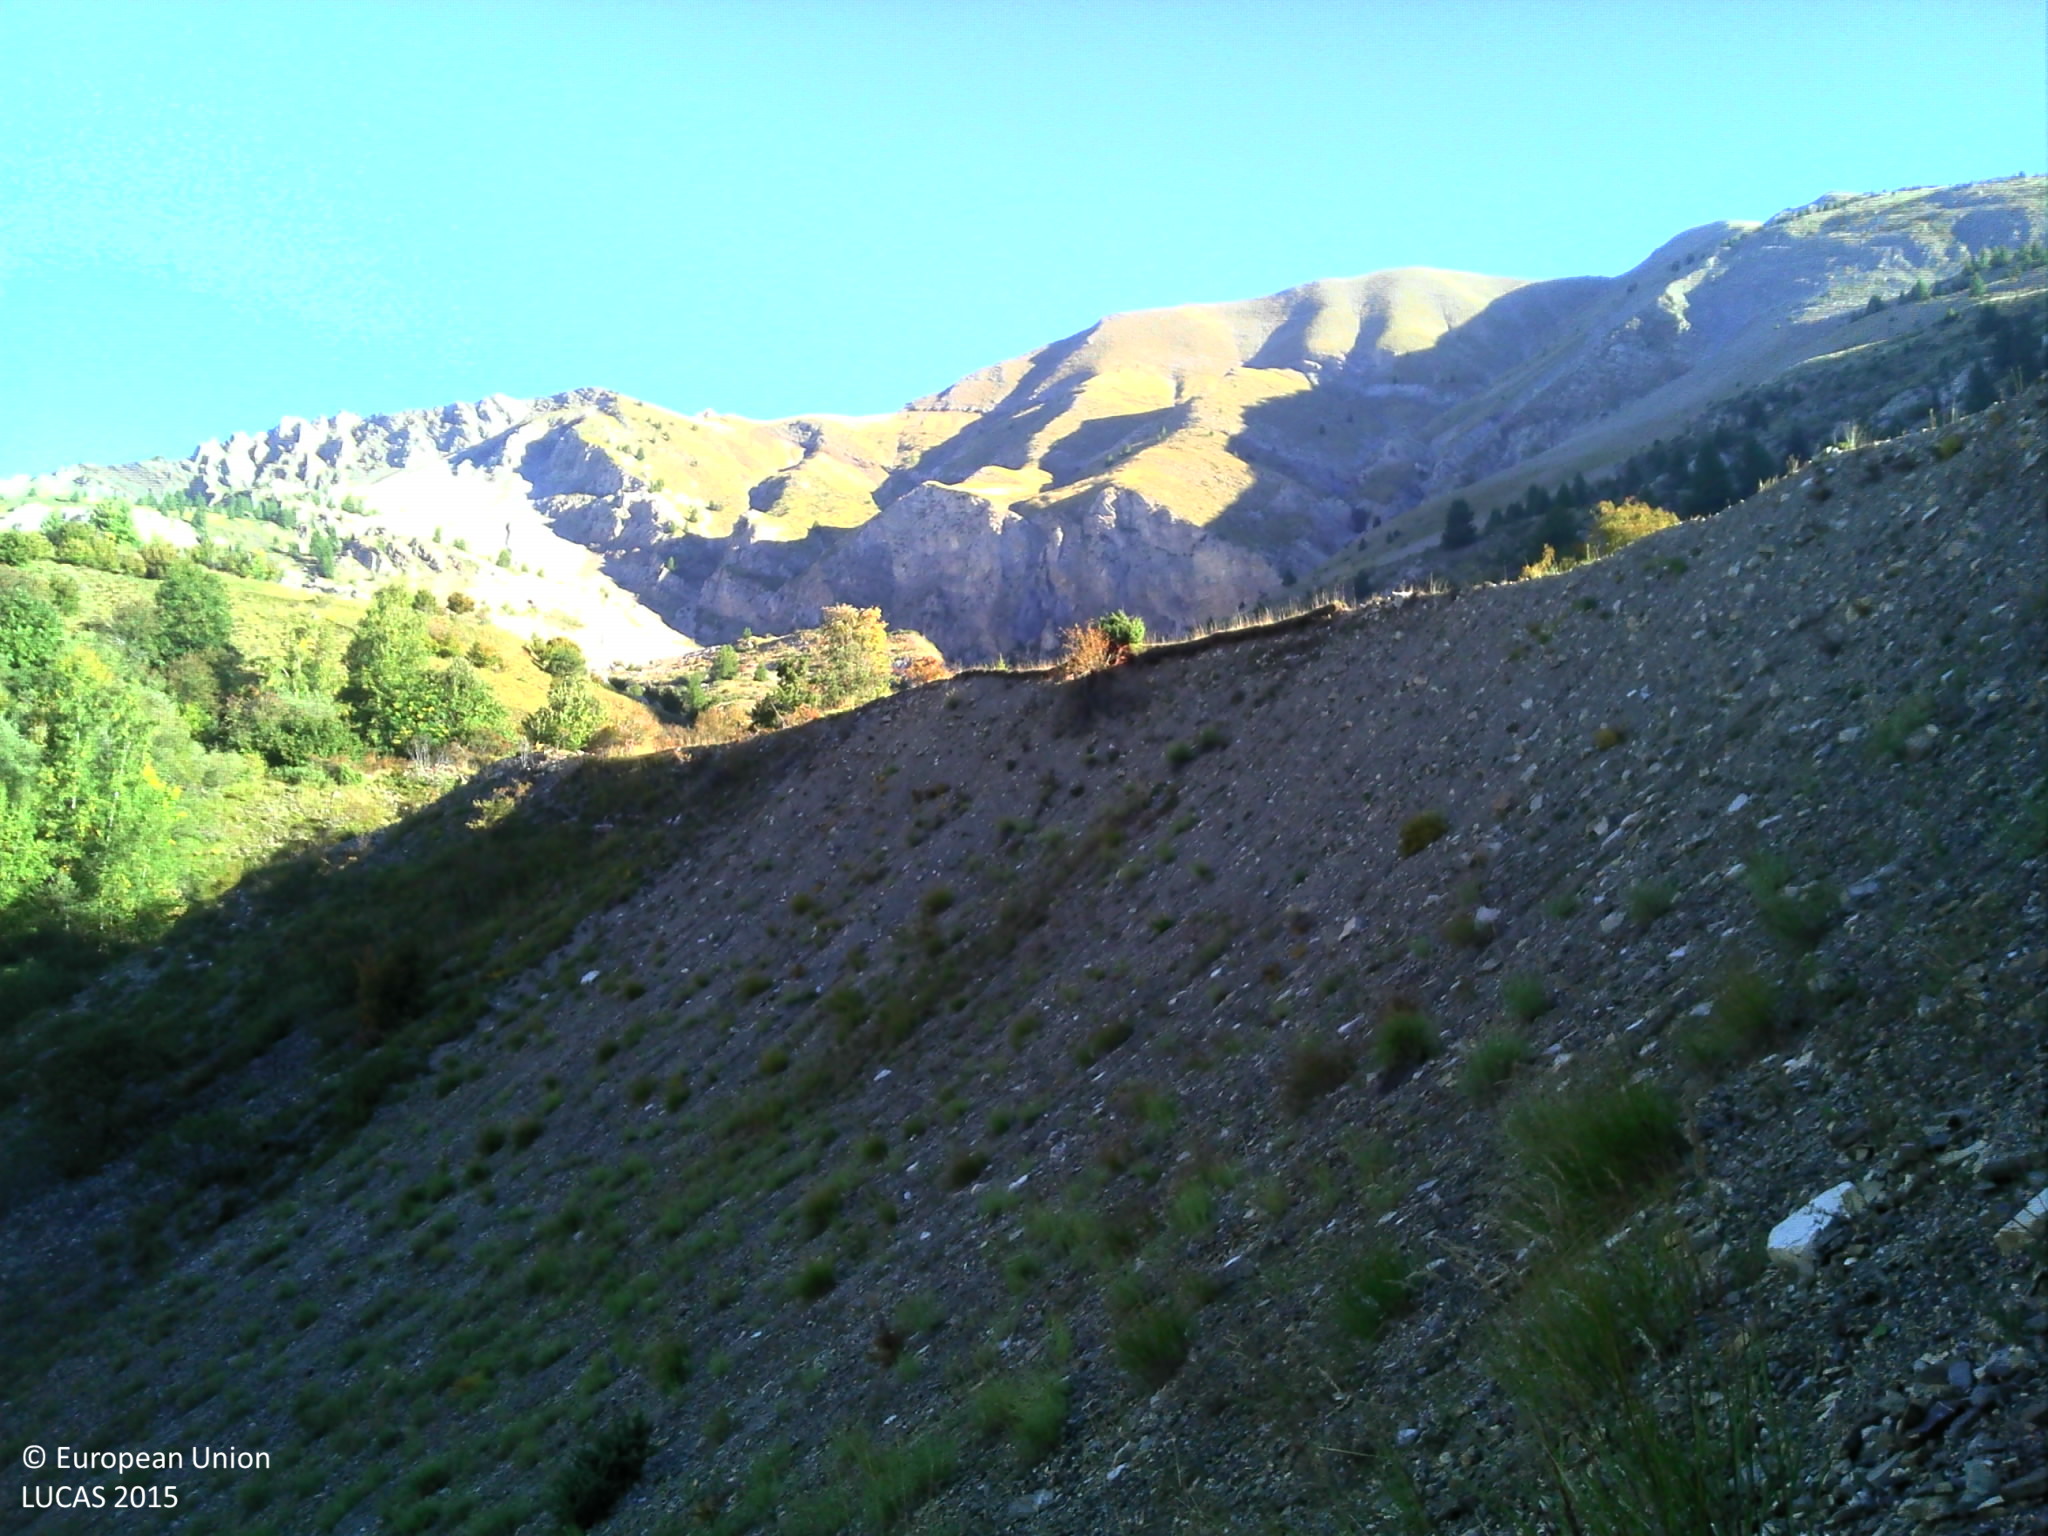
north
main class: Grassland
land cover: Spontaneously vegetated surfaces
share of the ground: 25 - 50 %
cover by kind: consolidated bare surface 60 %, herbaceous plants 40 %
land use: Semi-natural and natural areas not in use
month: September
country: FR
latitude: 44.6254
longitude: 6.2378
